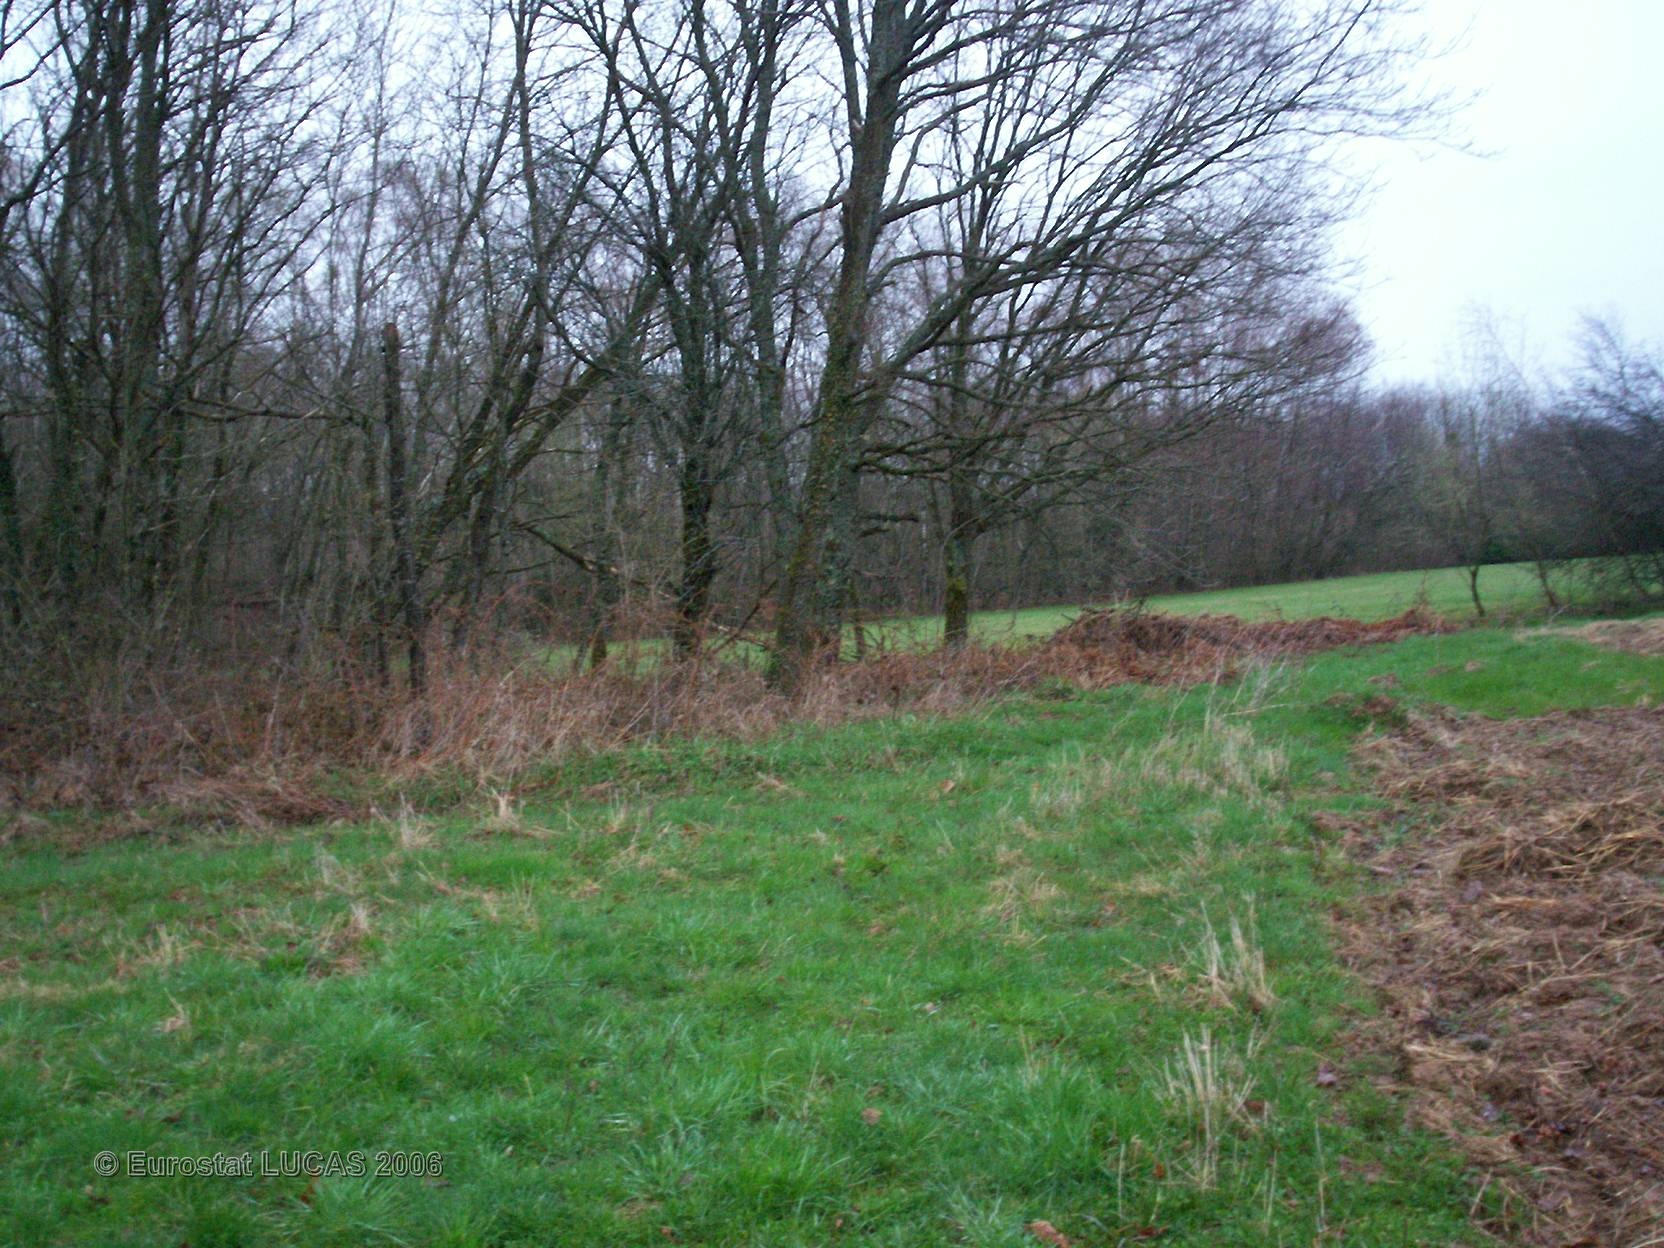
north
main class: Grassland
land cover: Grassland without tree/shrub cover
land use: Agriculture (excluding fallow land and kitchen gardens)
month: April
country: FR
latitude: 47.6122
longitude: 6.5825
